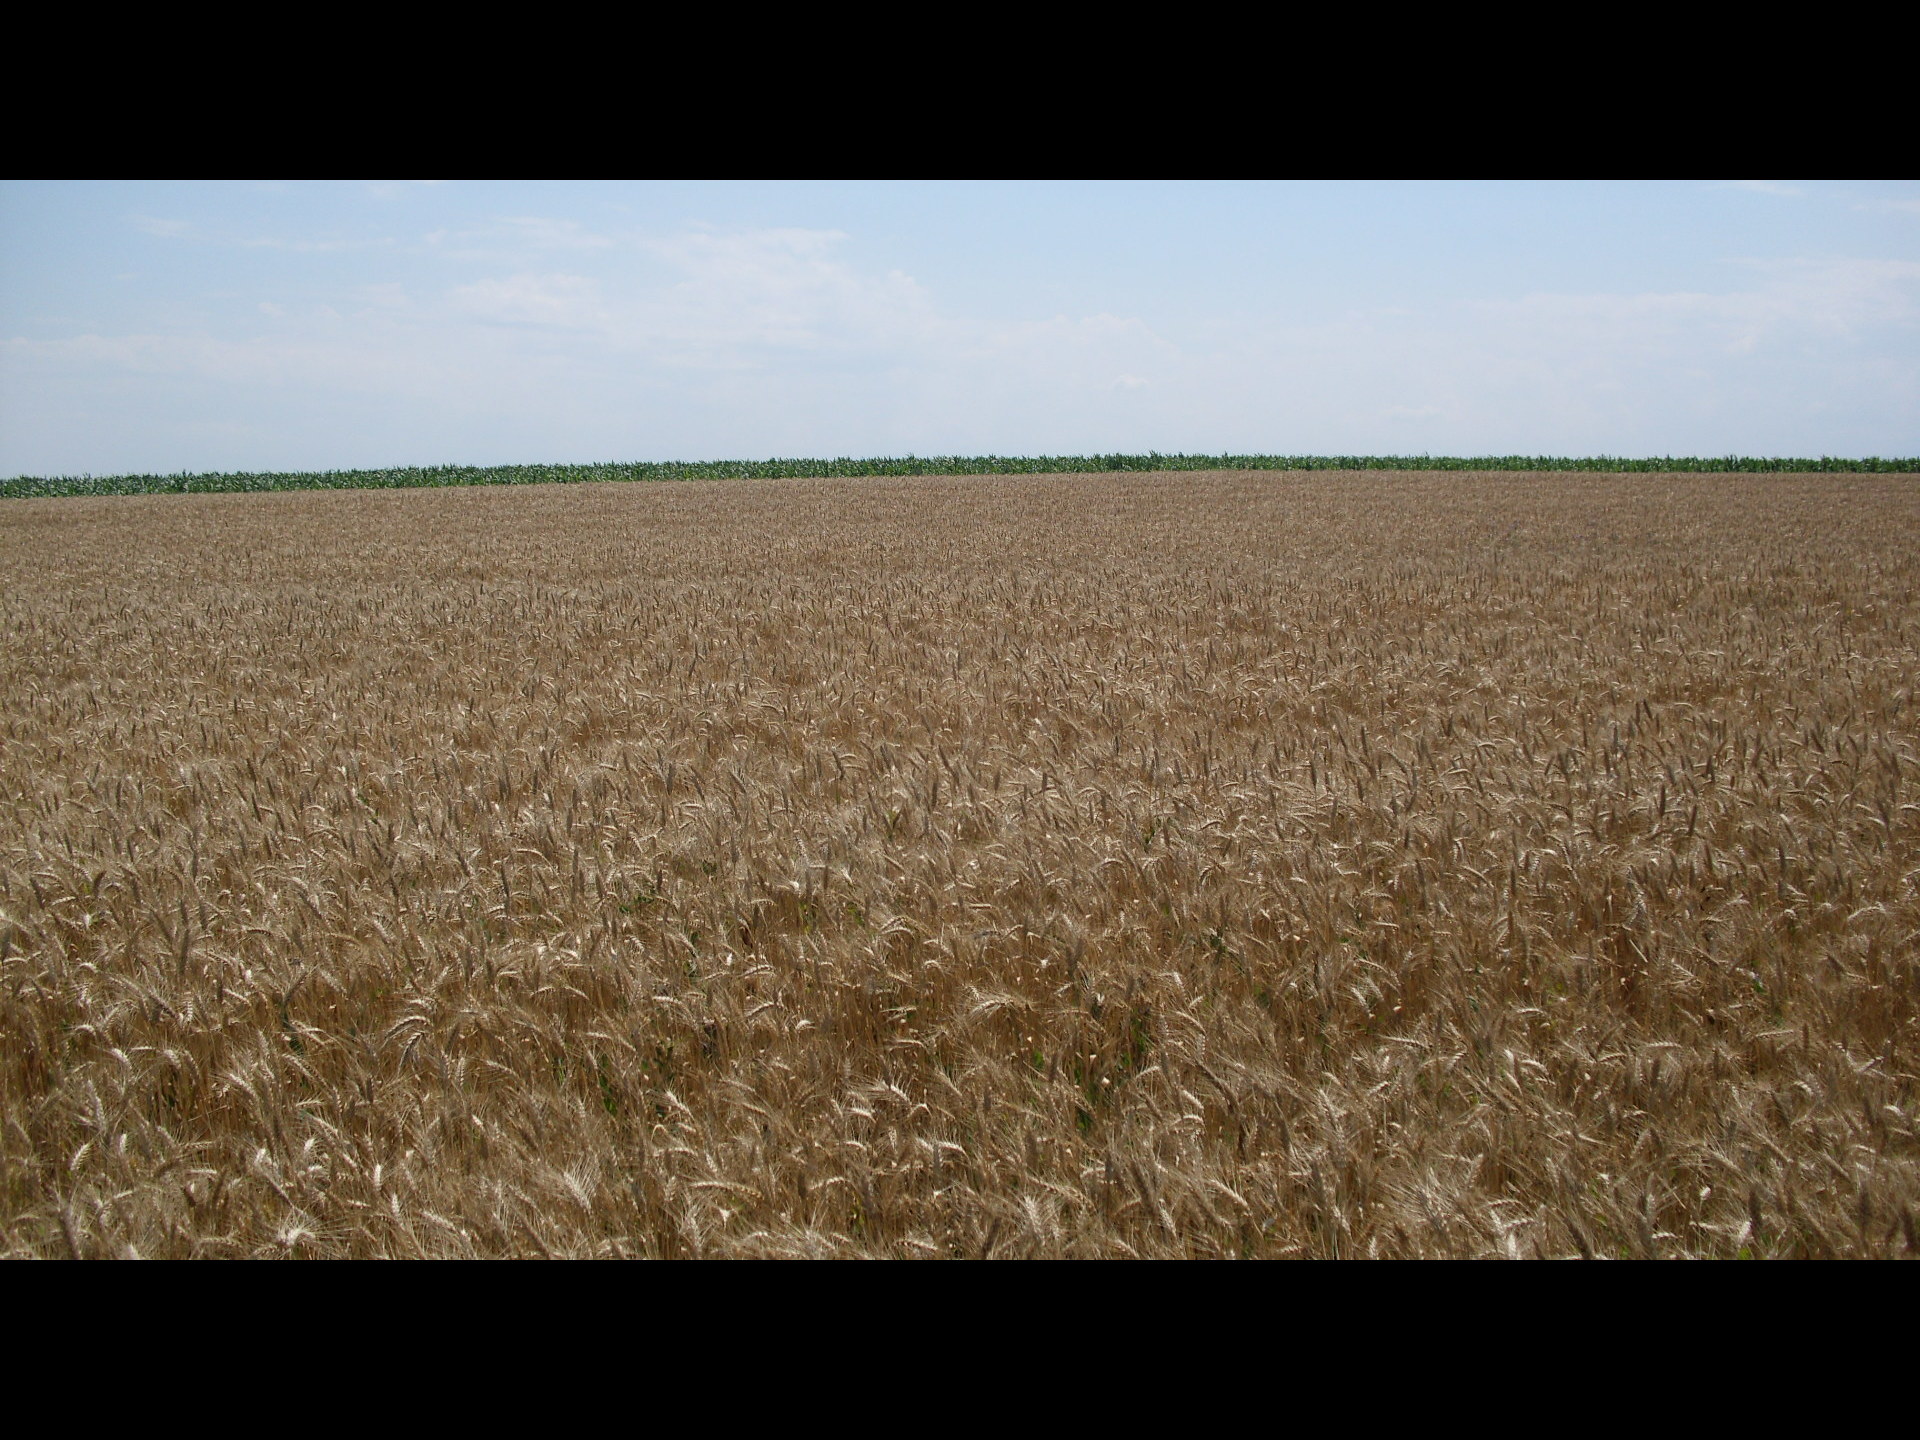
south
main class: Cropland
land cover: Common wheat
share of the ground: > 75 %
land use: Agriculture (excluding fallow land and kitchen gardens)
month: June
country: BG
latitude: 43.6225
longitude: 23.2650
